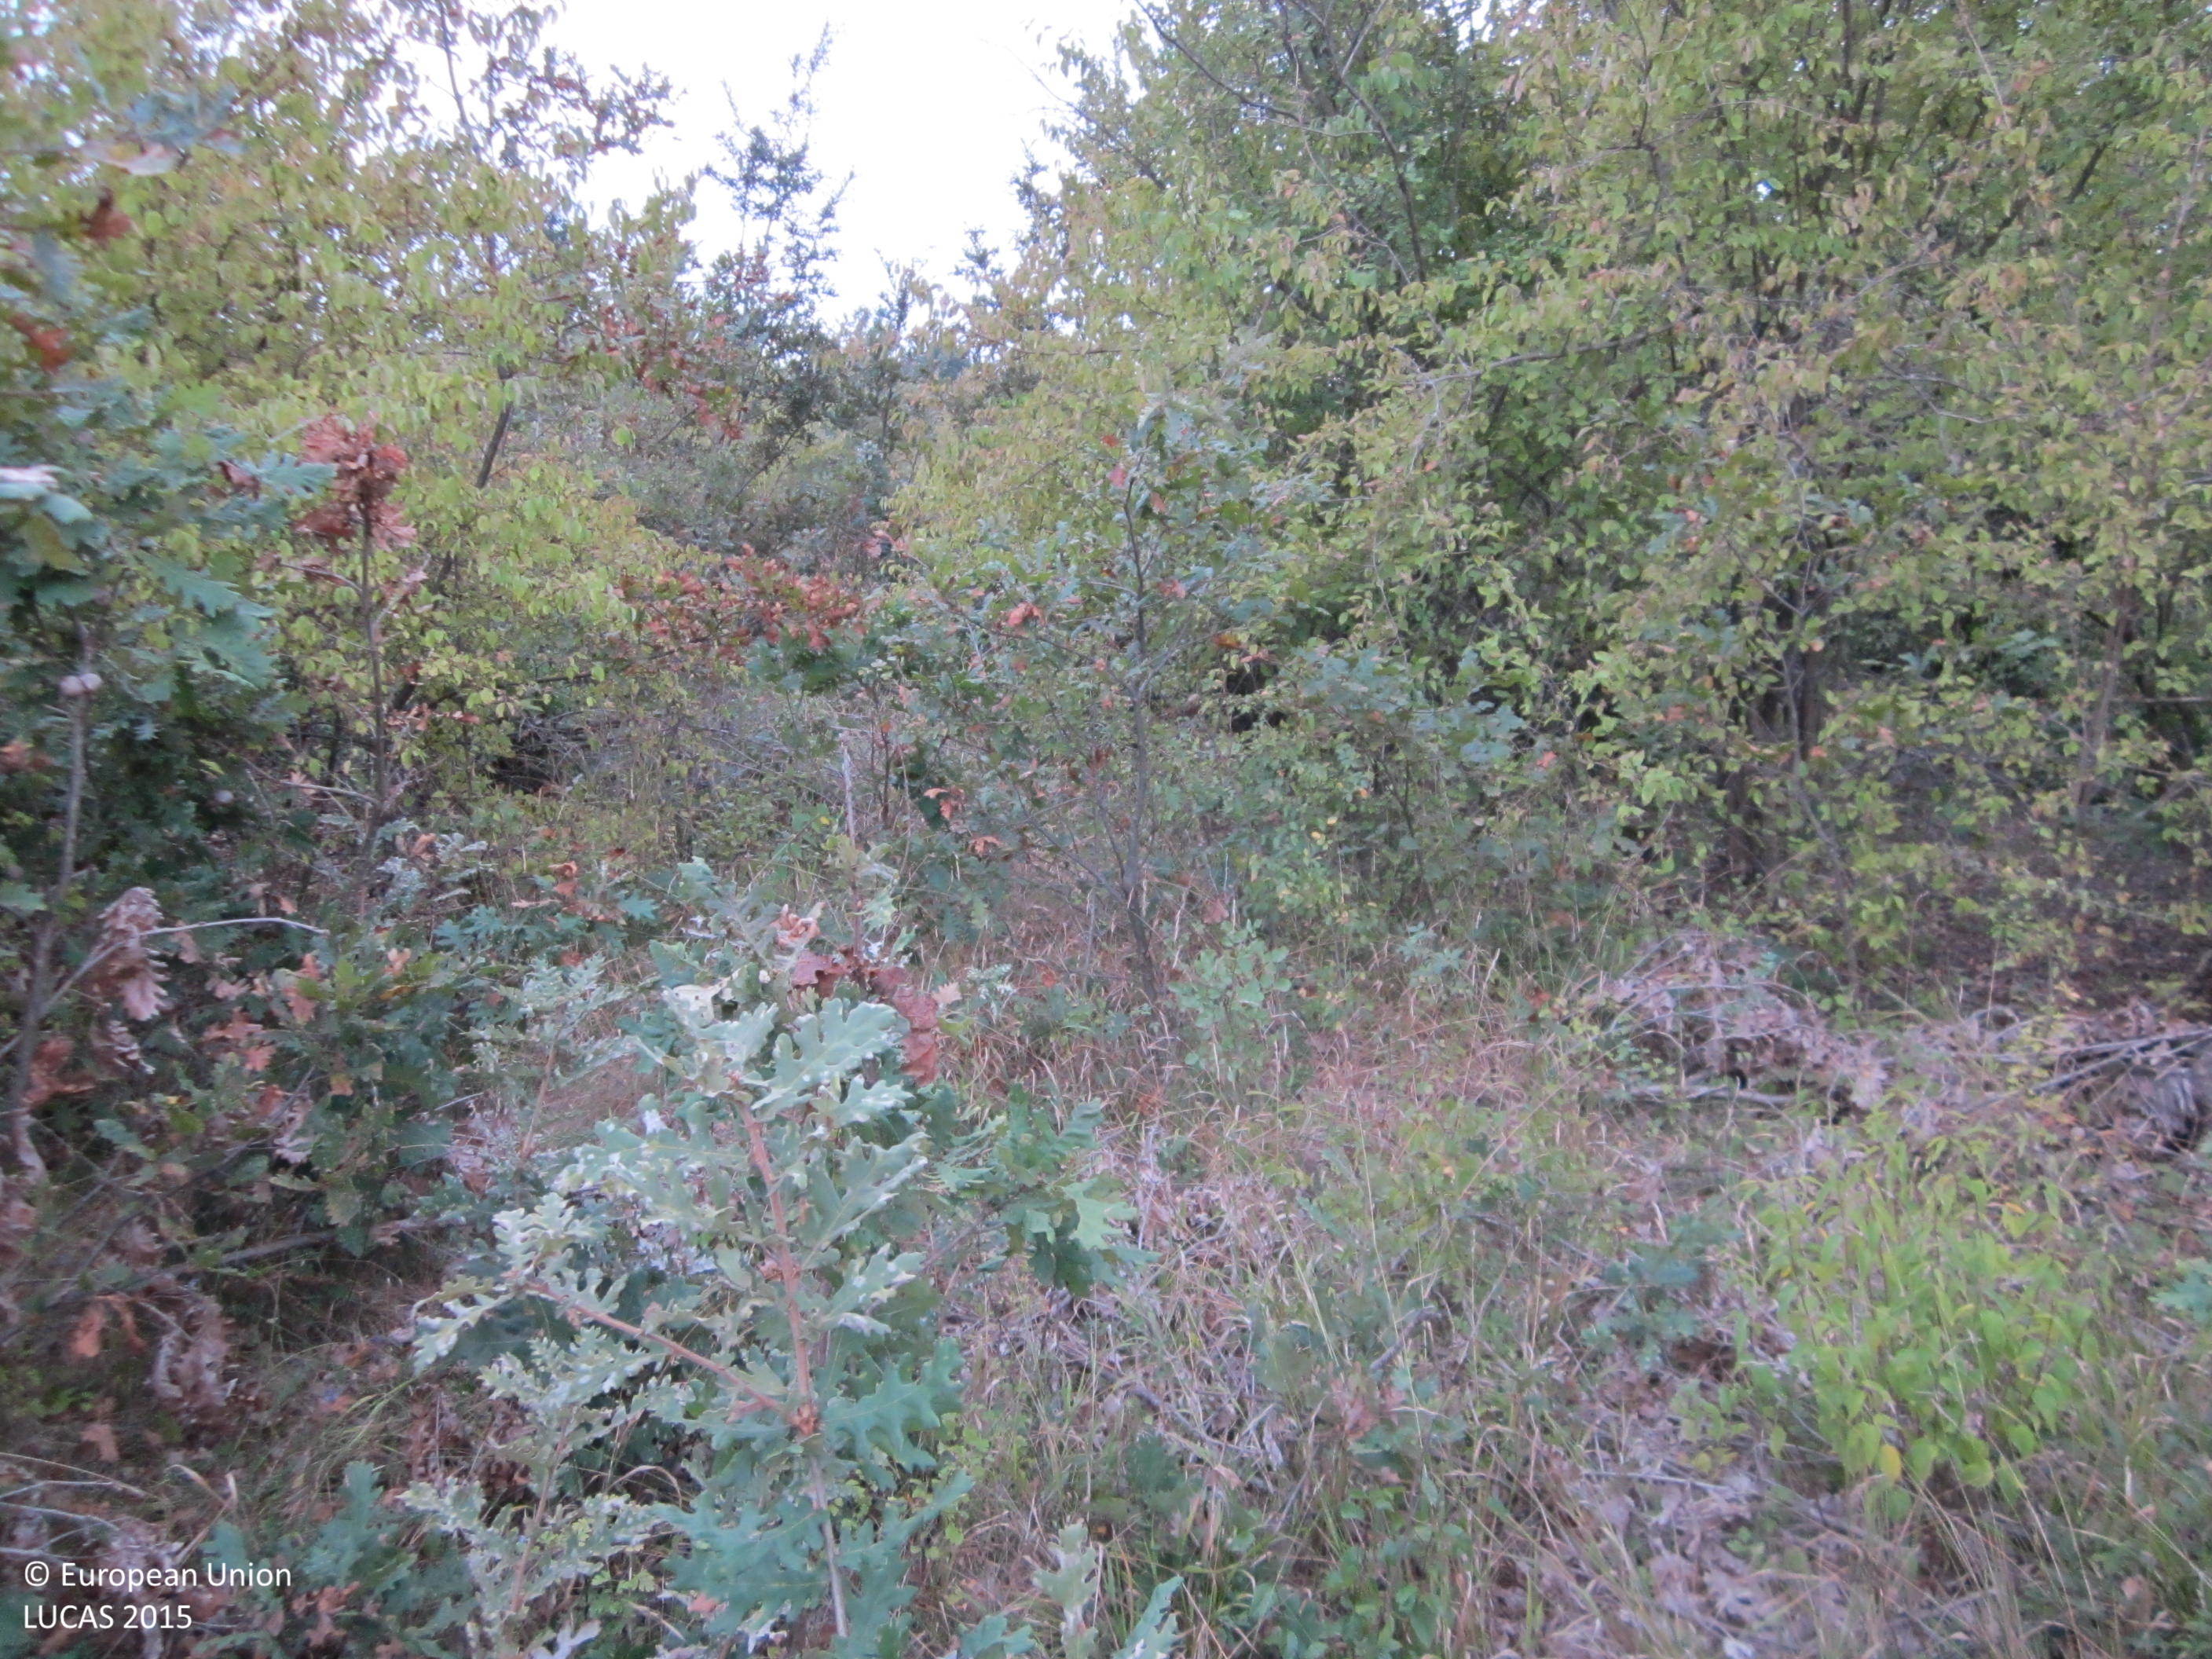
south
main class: Woodland
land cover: Broadleaved woodland
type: thermophilous deciduous forest
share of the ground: 50 - 75 %
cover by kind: broadleaved forest trees 60 %, herbaceous plants 30 %, shrubs 10 %
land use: Forestry
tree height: > 5 m
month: September
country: BG
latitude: 42.7805
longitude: 27.3651
